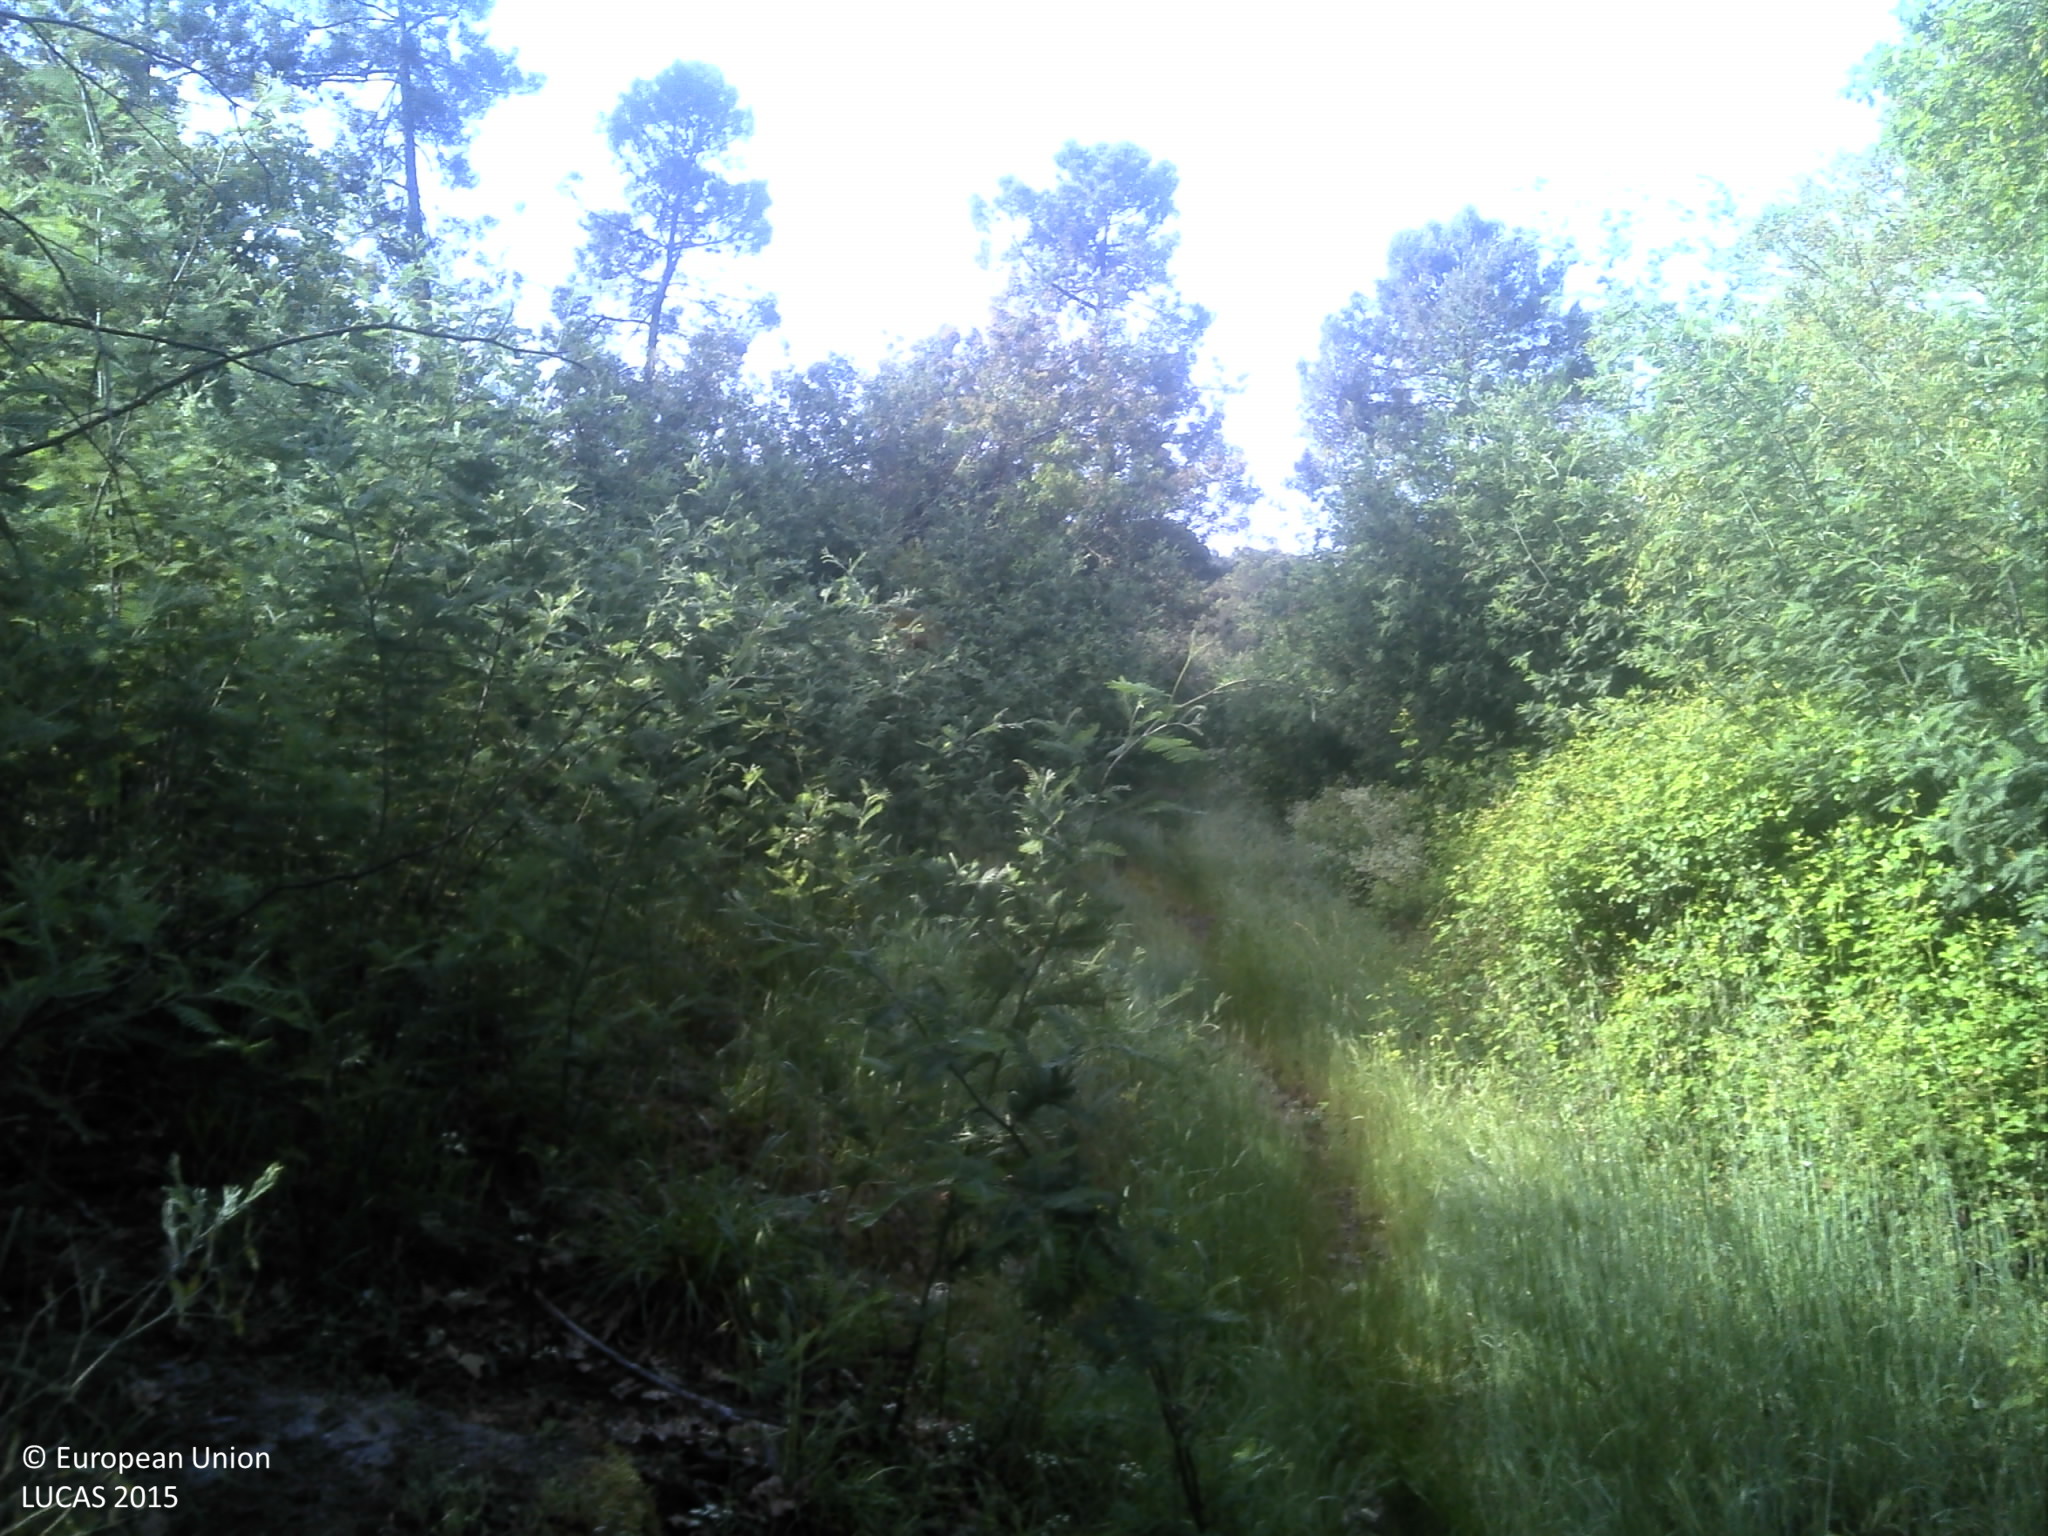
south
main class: Woodland
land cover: Broadleaved woodland
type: acidophilous oak and oak-birch forest
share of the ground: 25 - 50 %
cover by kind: broadleaved forest trees 50 %, shrubs 25 %, herbaceous plants 15 %, unconsolidated bare surface 10 %
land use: Forestry
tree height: > 5 m
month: May
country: PT
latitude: 40.6599
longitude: -7.7800
